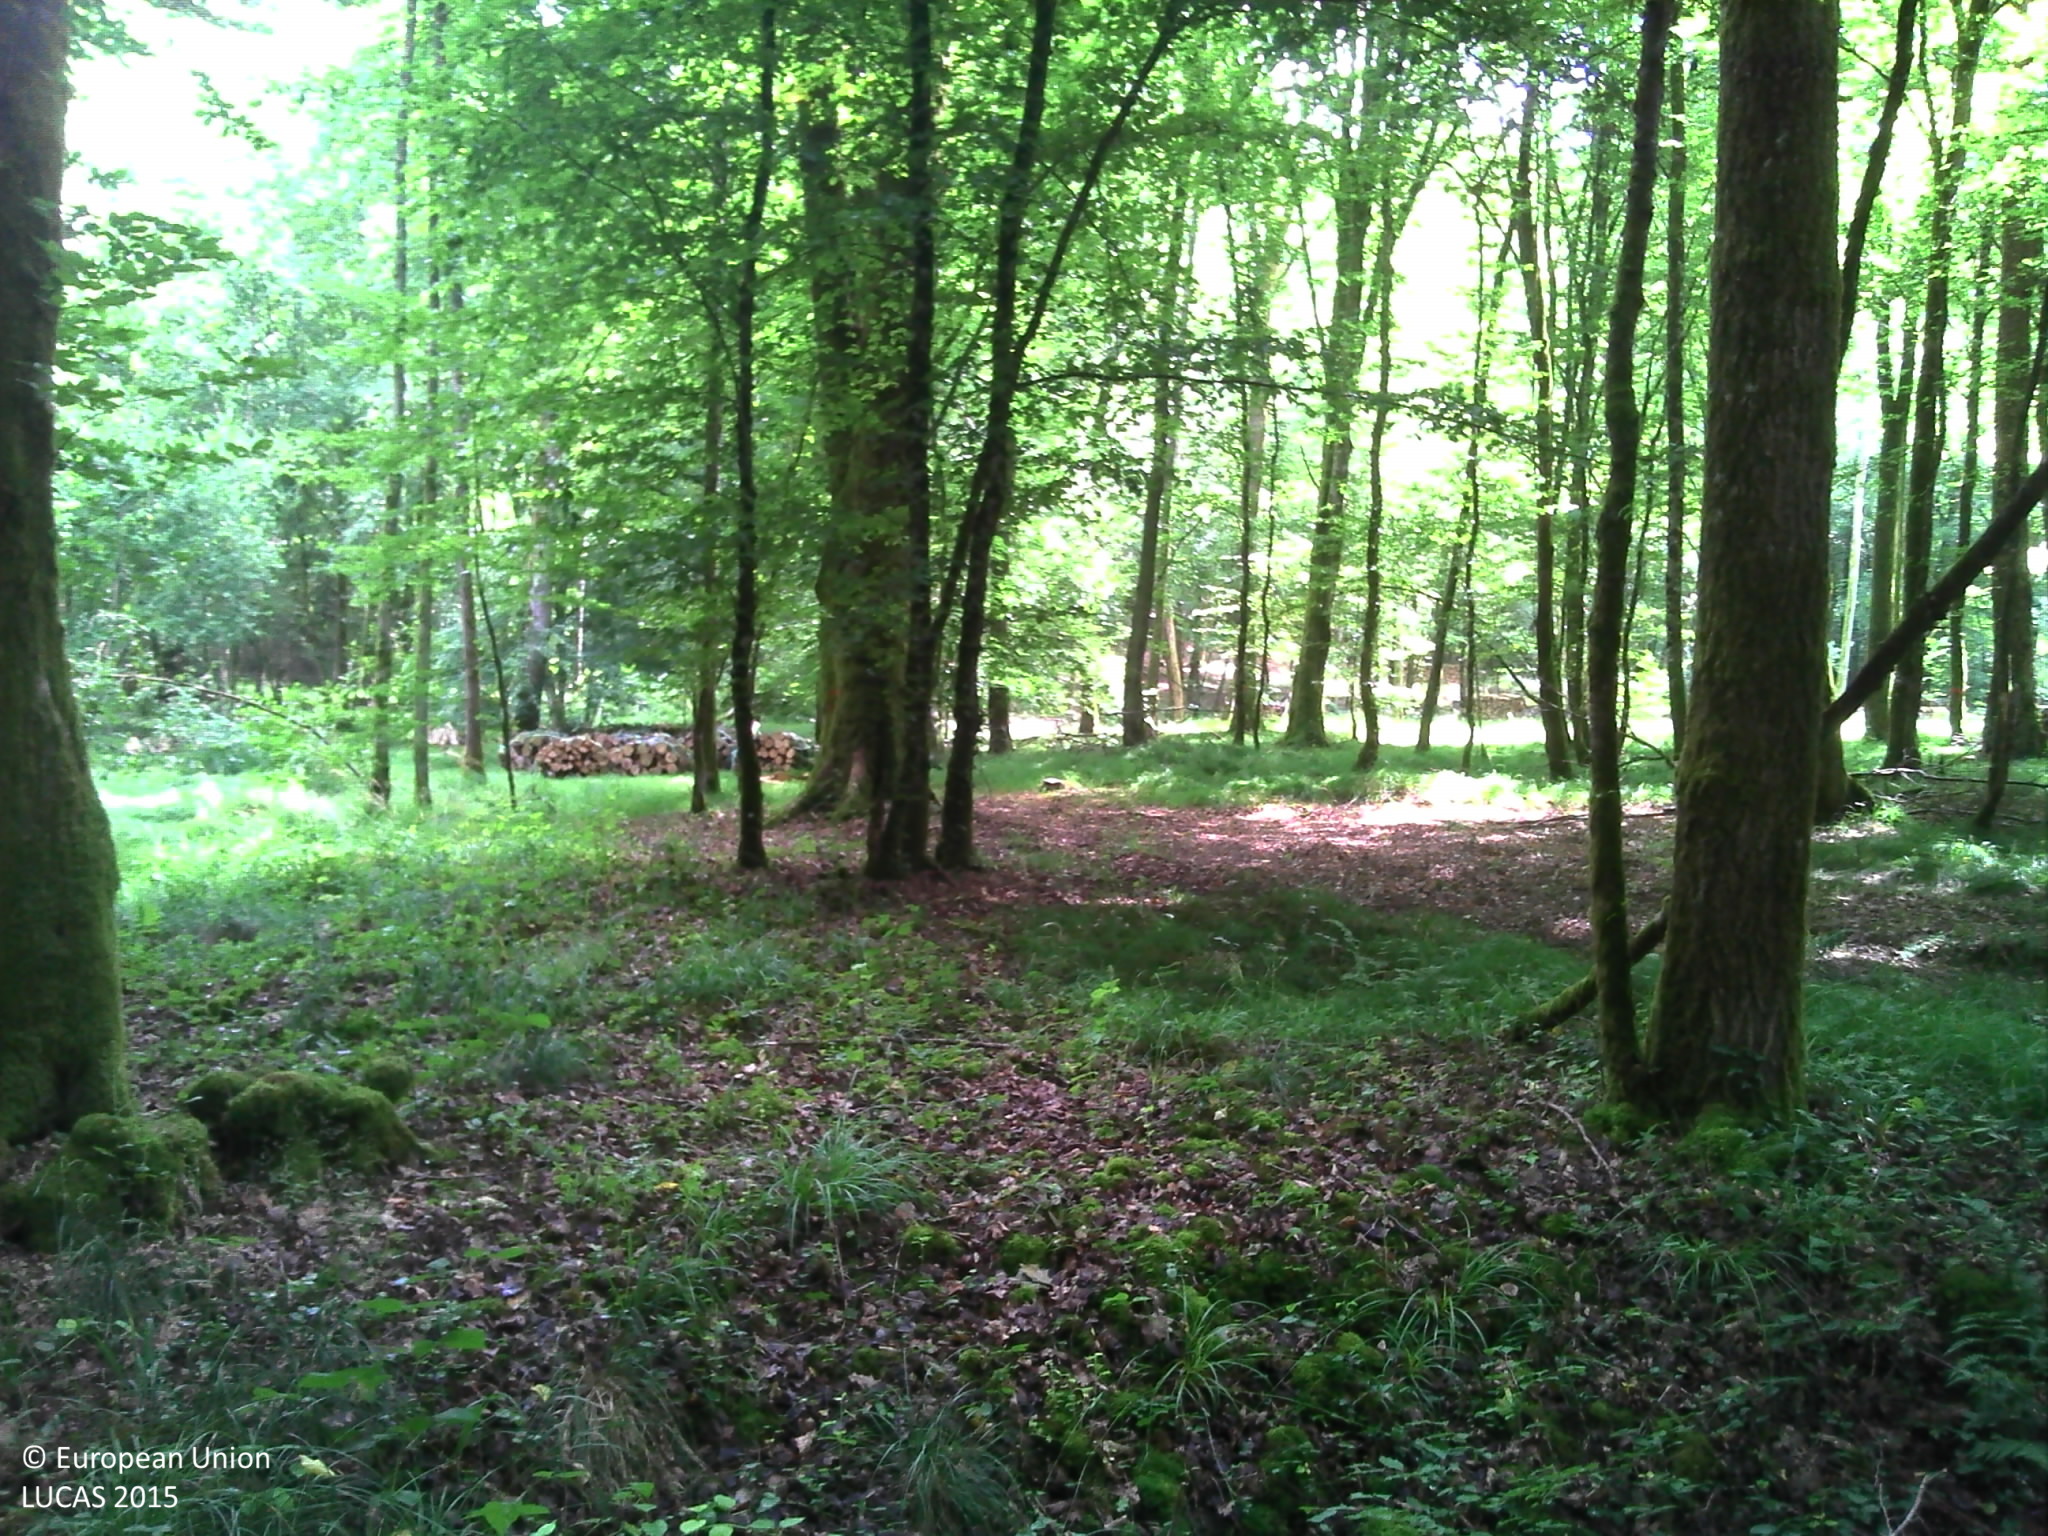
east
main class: Woodland
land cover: Broadleaved woodland
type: mesophytic deciduous forest
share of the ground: > 75 %
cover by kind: broadleaved forest trees 95 %, herbaceous plants 5 %
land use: Forestry
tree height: > 5 m
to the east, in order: Broadleaved woodland; Tracks; Spruce dominated coniferous woodland; Broadleaved woodland
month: July
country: FR
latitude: 49.2140
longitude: 5.0971
